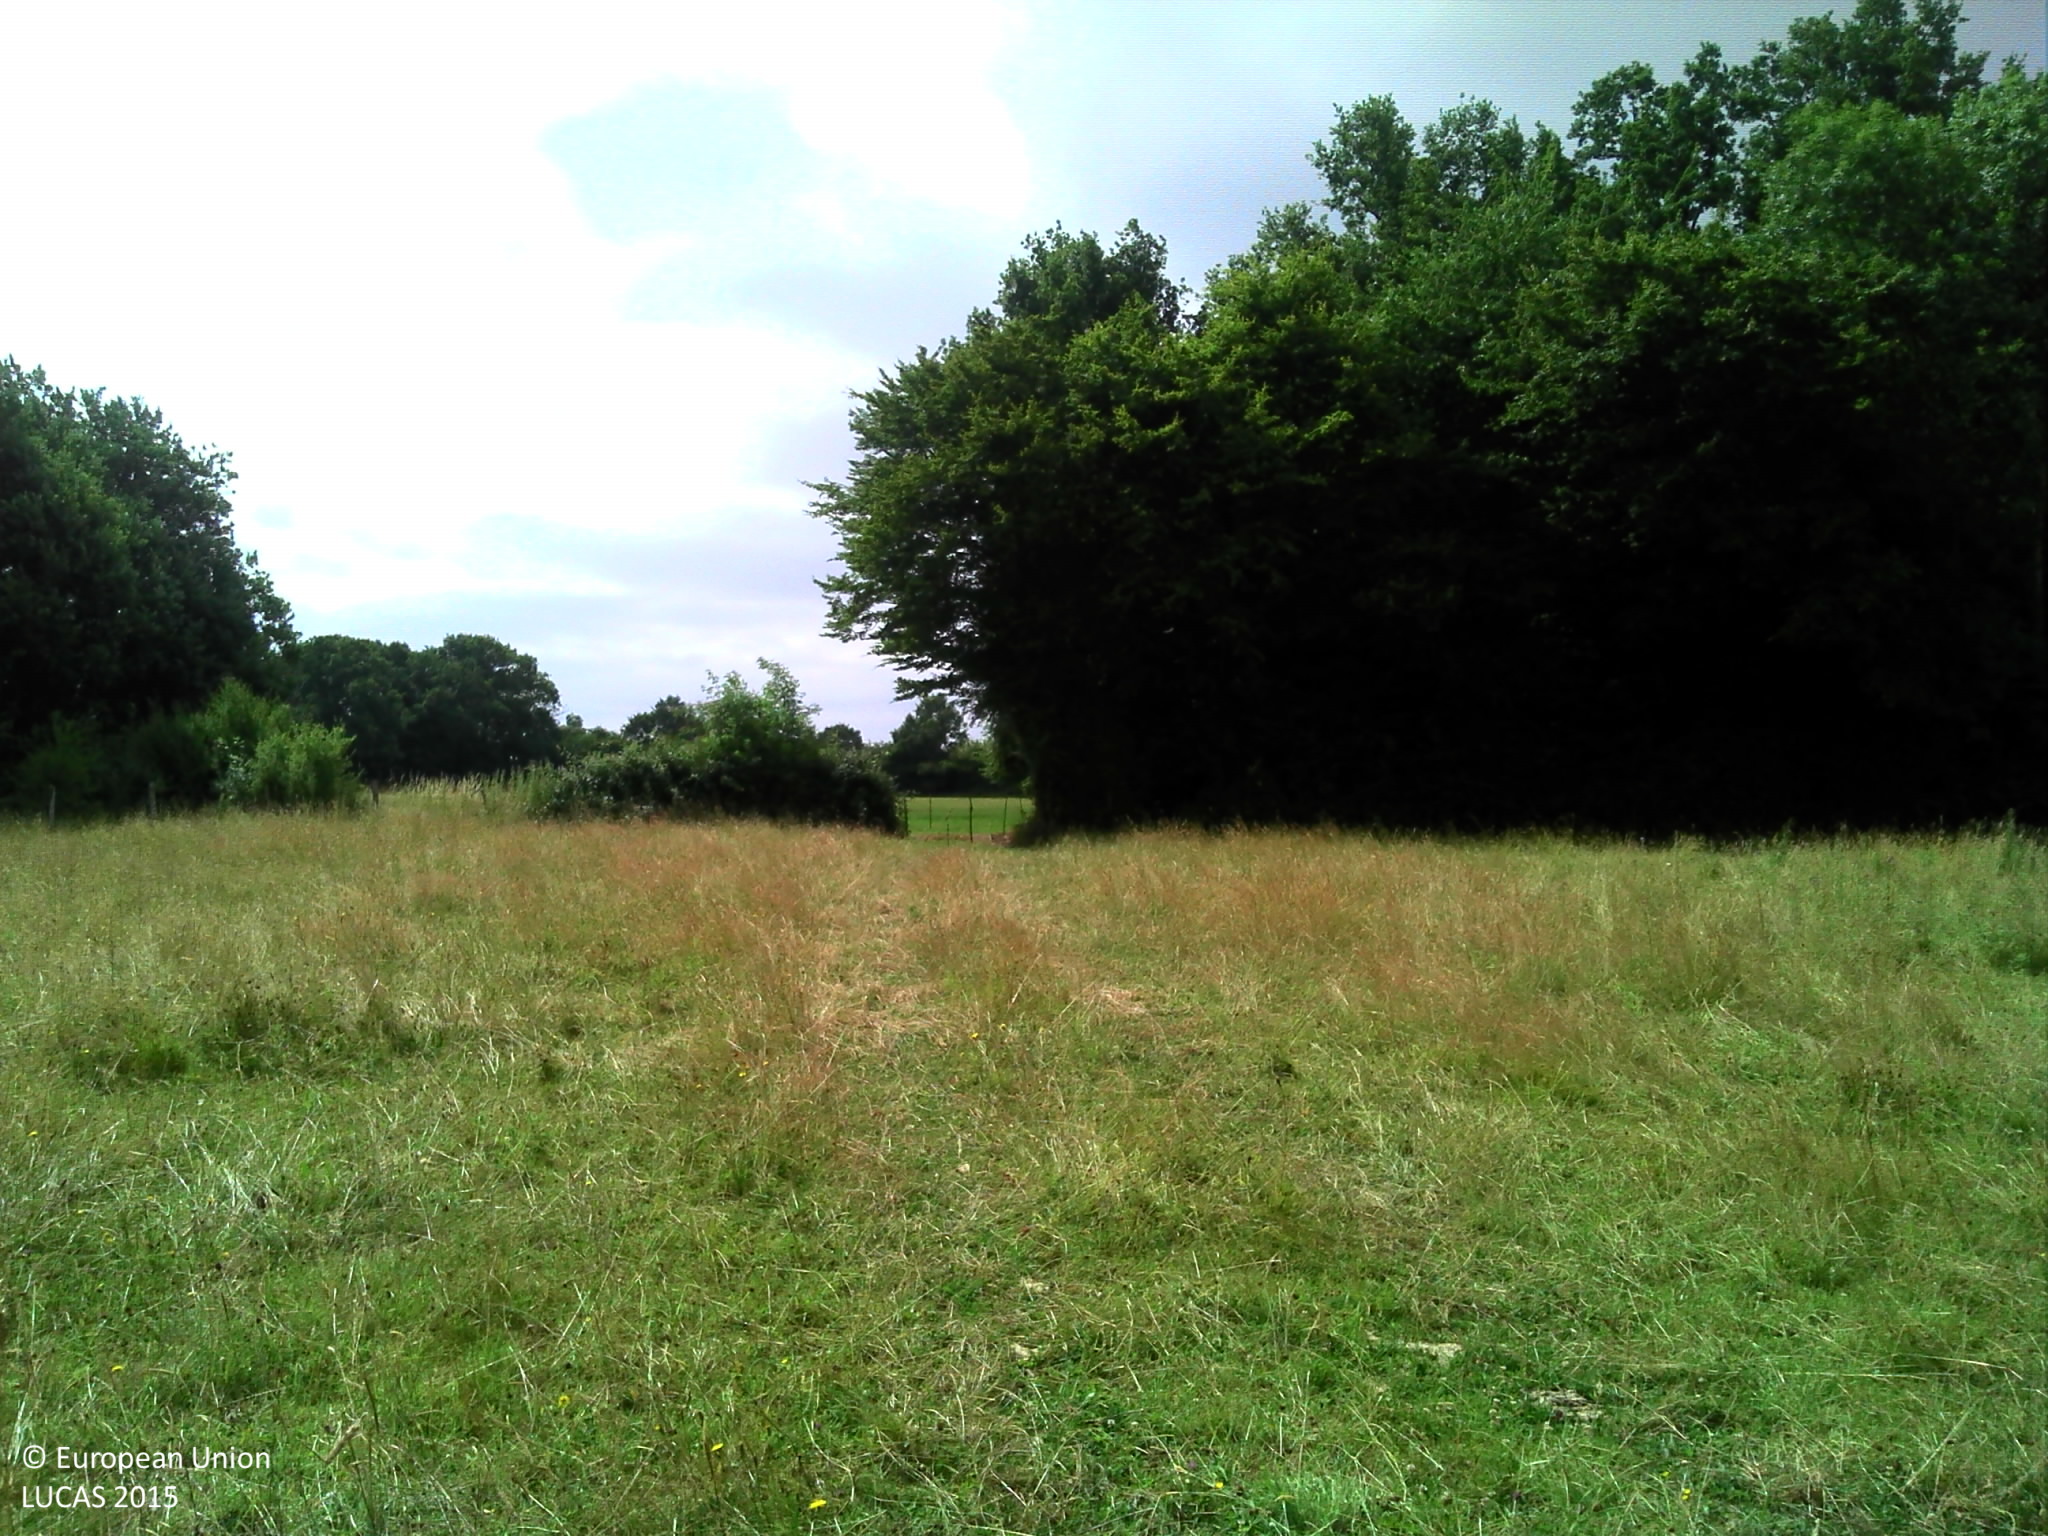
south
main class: Grassland
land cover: Grassland with sparse tree/shrub cover
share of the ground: > 75 %
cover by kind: herbaceous plants 95 %, broadleaved forest trees 5 %
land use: Agriculture (excluding fallow land and kitchen gardens)
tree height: < 5 m
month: July
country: FR
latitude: 48.9189
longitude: 0.5173
